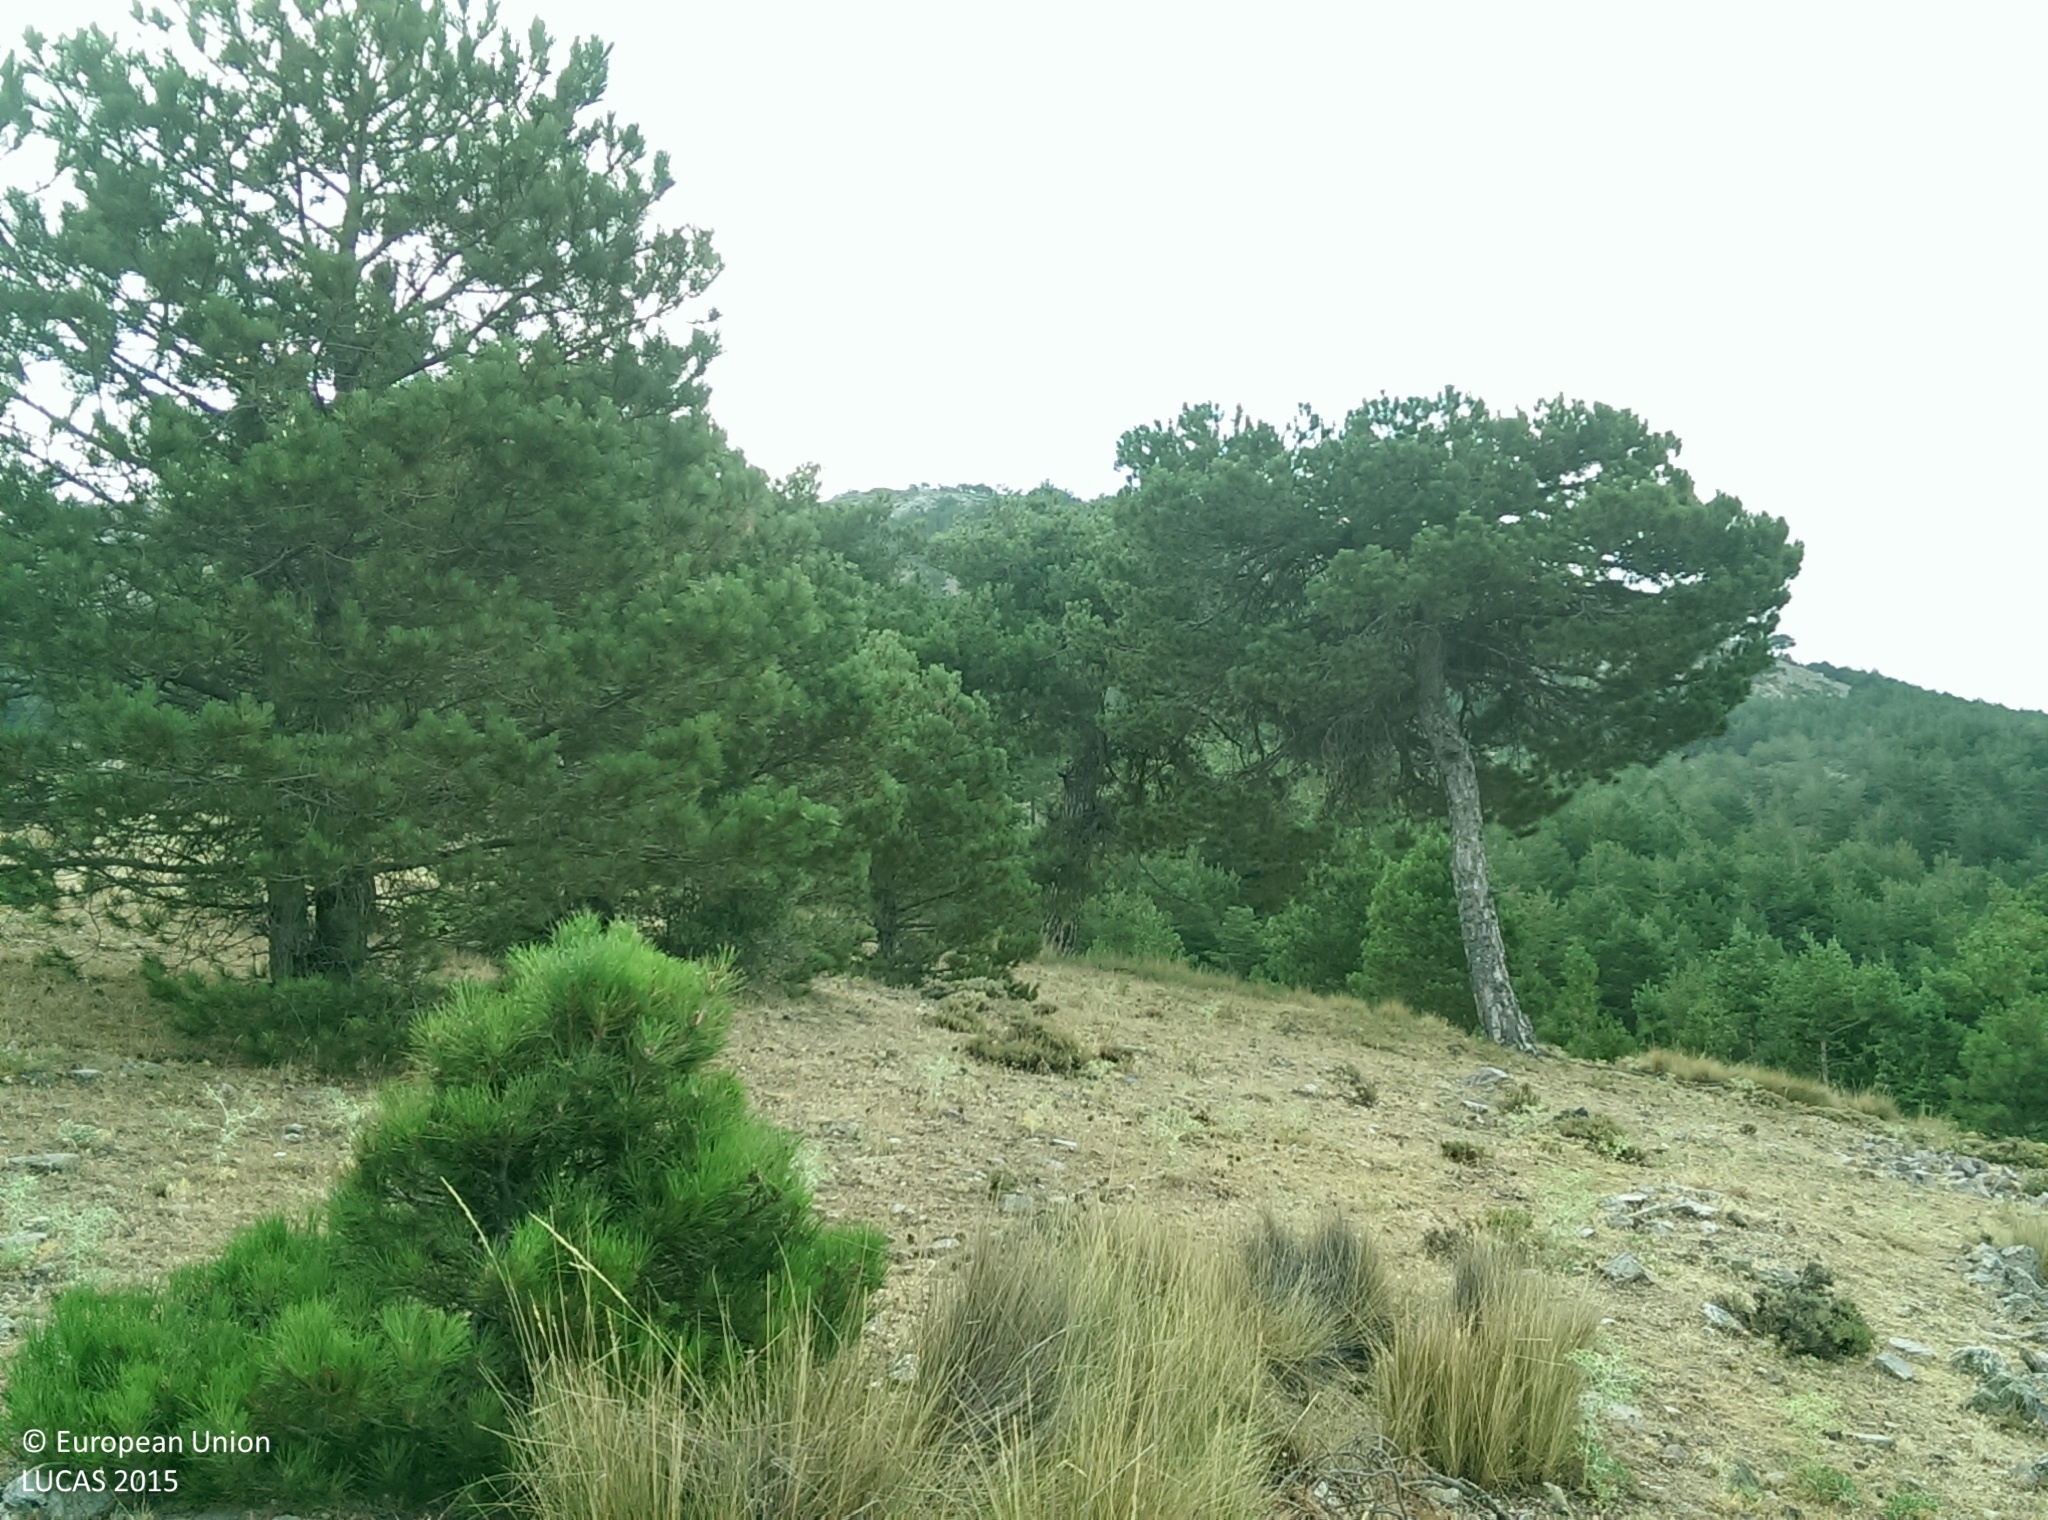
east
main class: Woodland
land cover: Pine dominated coniferous woodland
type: alpine coniferous forest
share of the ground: > 75 %
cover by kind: coniferous forest trees 80 %, shrubs 5 %, herbaceous plants 5 %, consolidated bare surface 5 %, unconsolidated bare surface 5 %
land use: Forestry
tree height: > 5 m
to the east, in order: Pine dominated coniferous woodland; Shrubland with sparse tree cover; Grassland with sparse tree/shrub cover; Shrubland with sparse tree cover
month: July
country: ES
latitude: 37.3286
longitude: -2.8624
